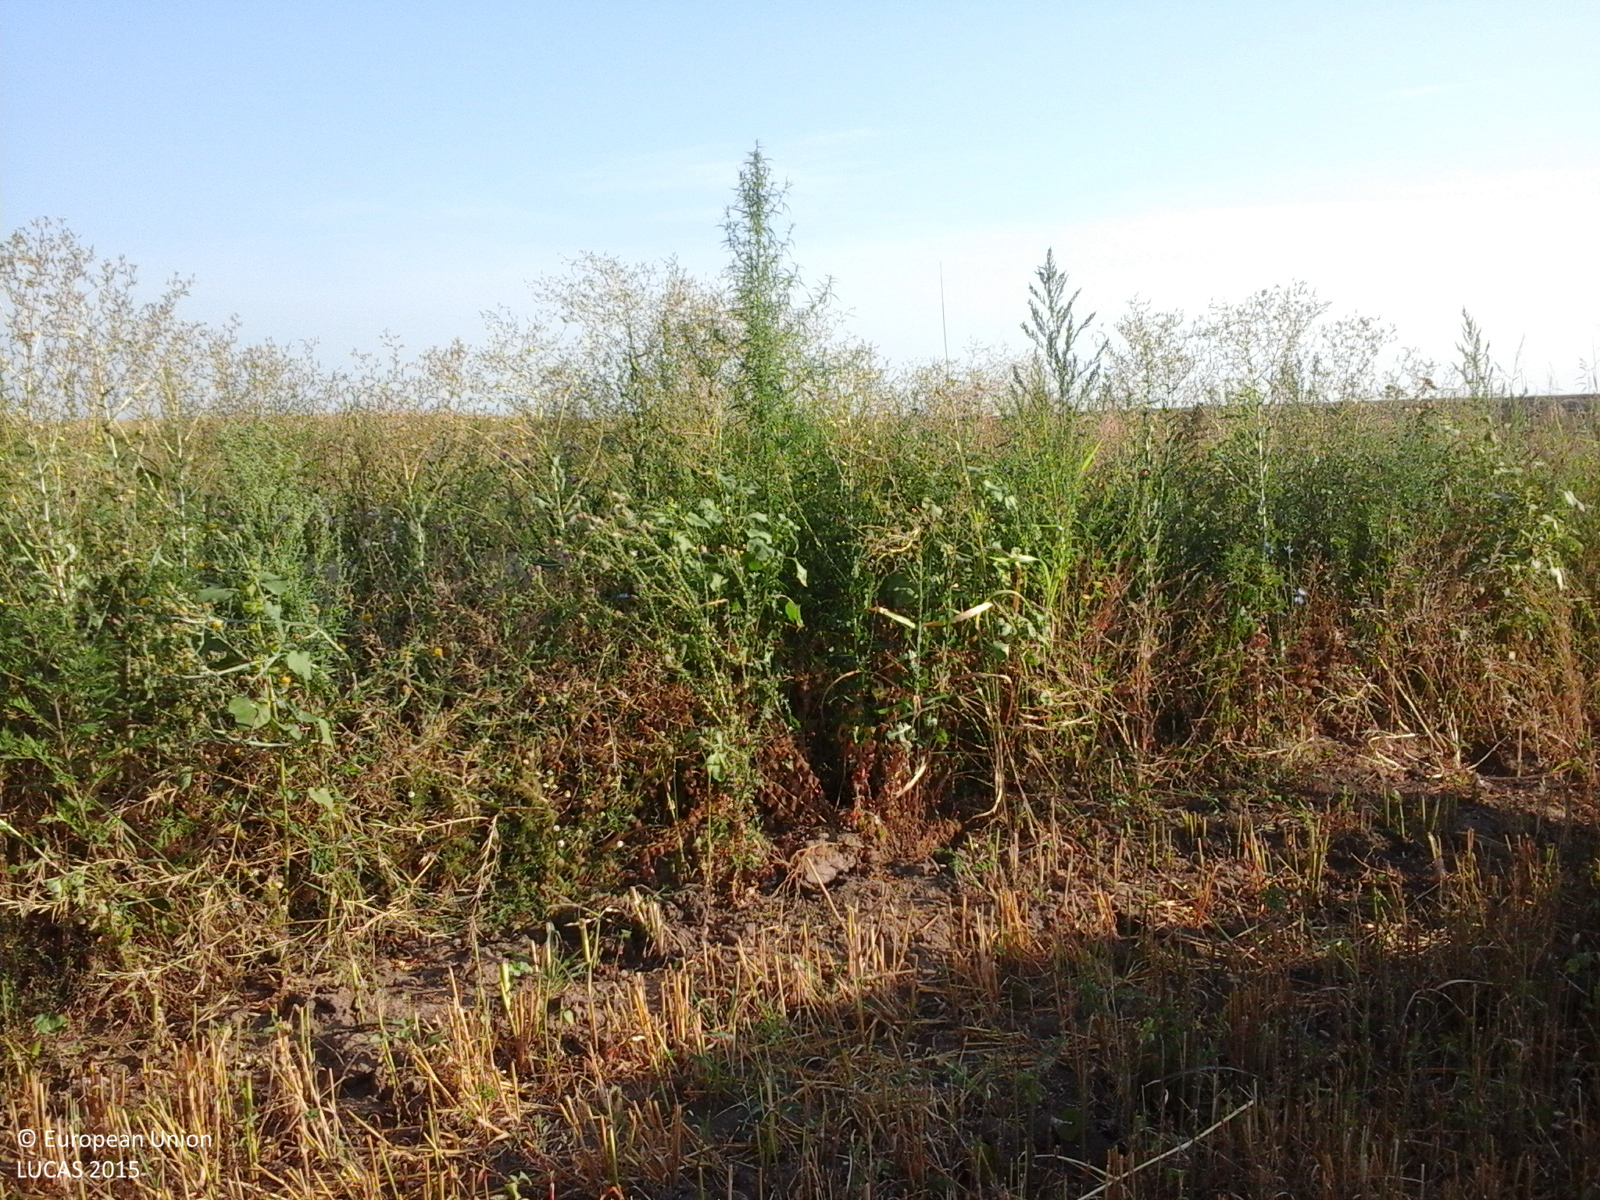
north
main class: Cropland
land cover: Oats
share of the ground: > 75 %
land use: Agriculture (excluding fallow land and kitchen gardens)
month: August
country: RO
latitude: 44.0669
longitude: 23.2168
